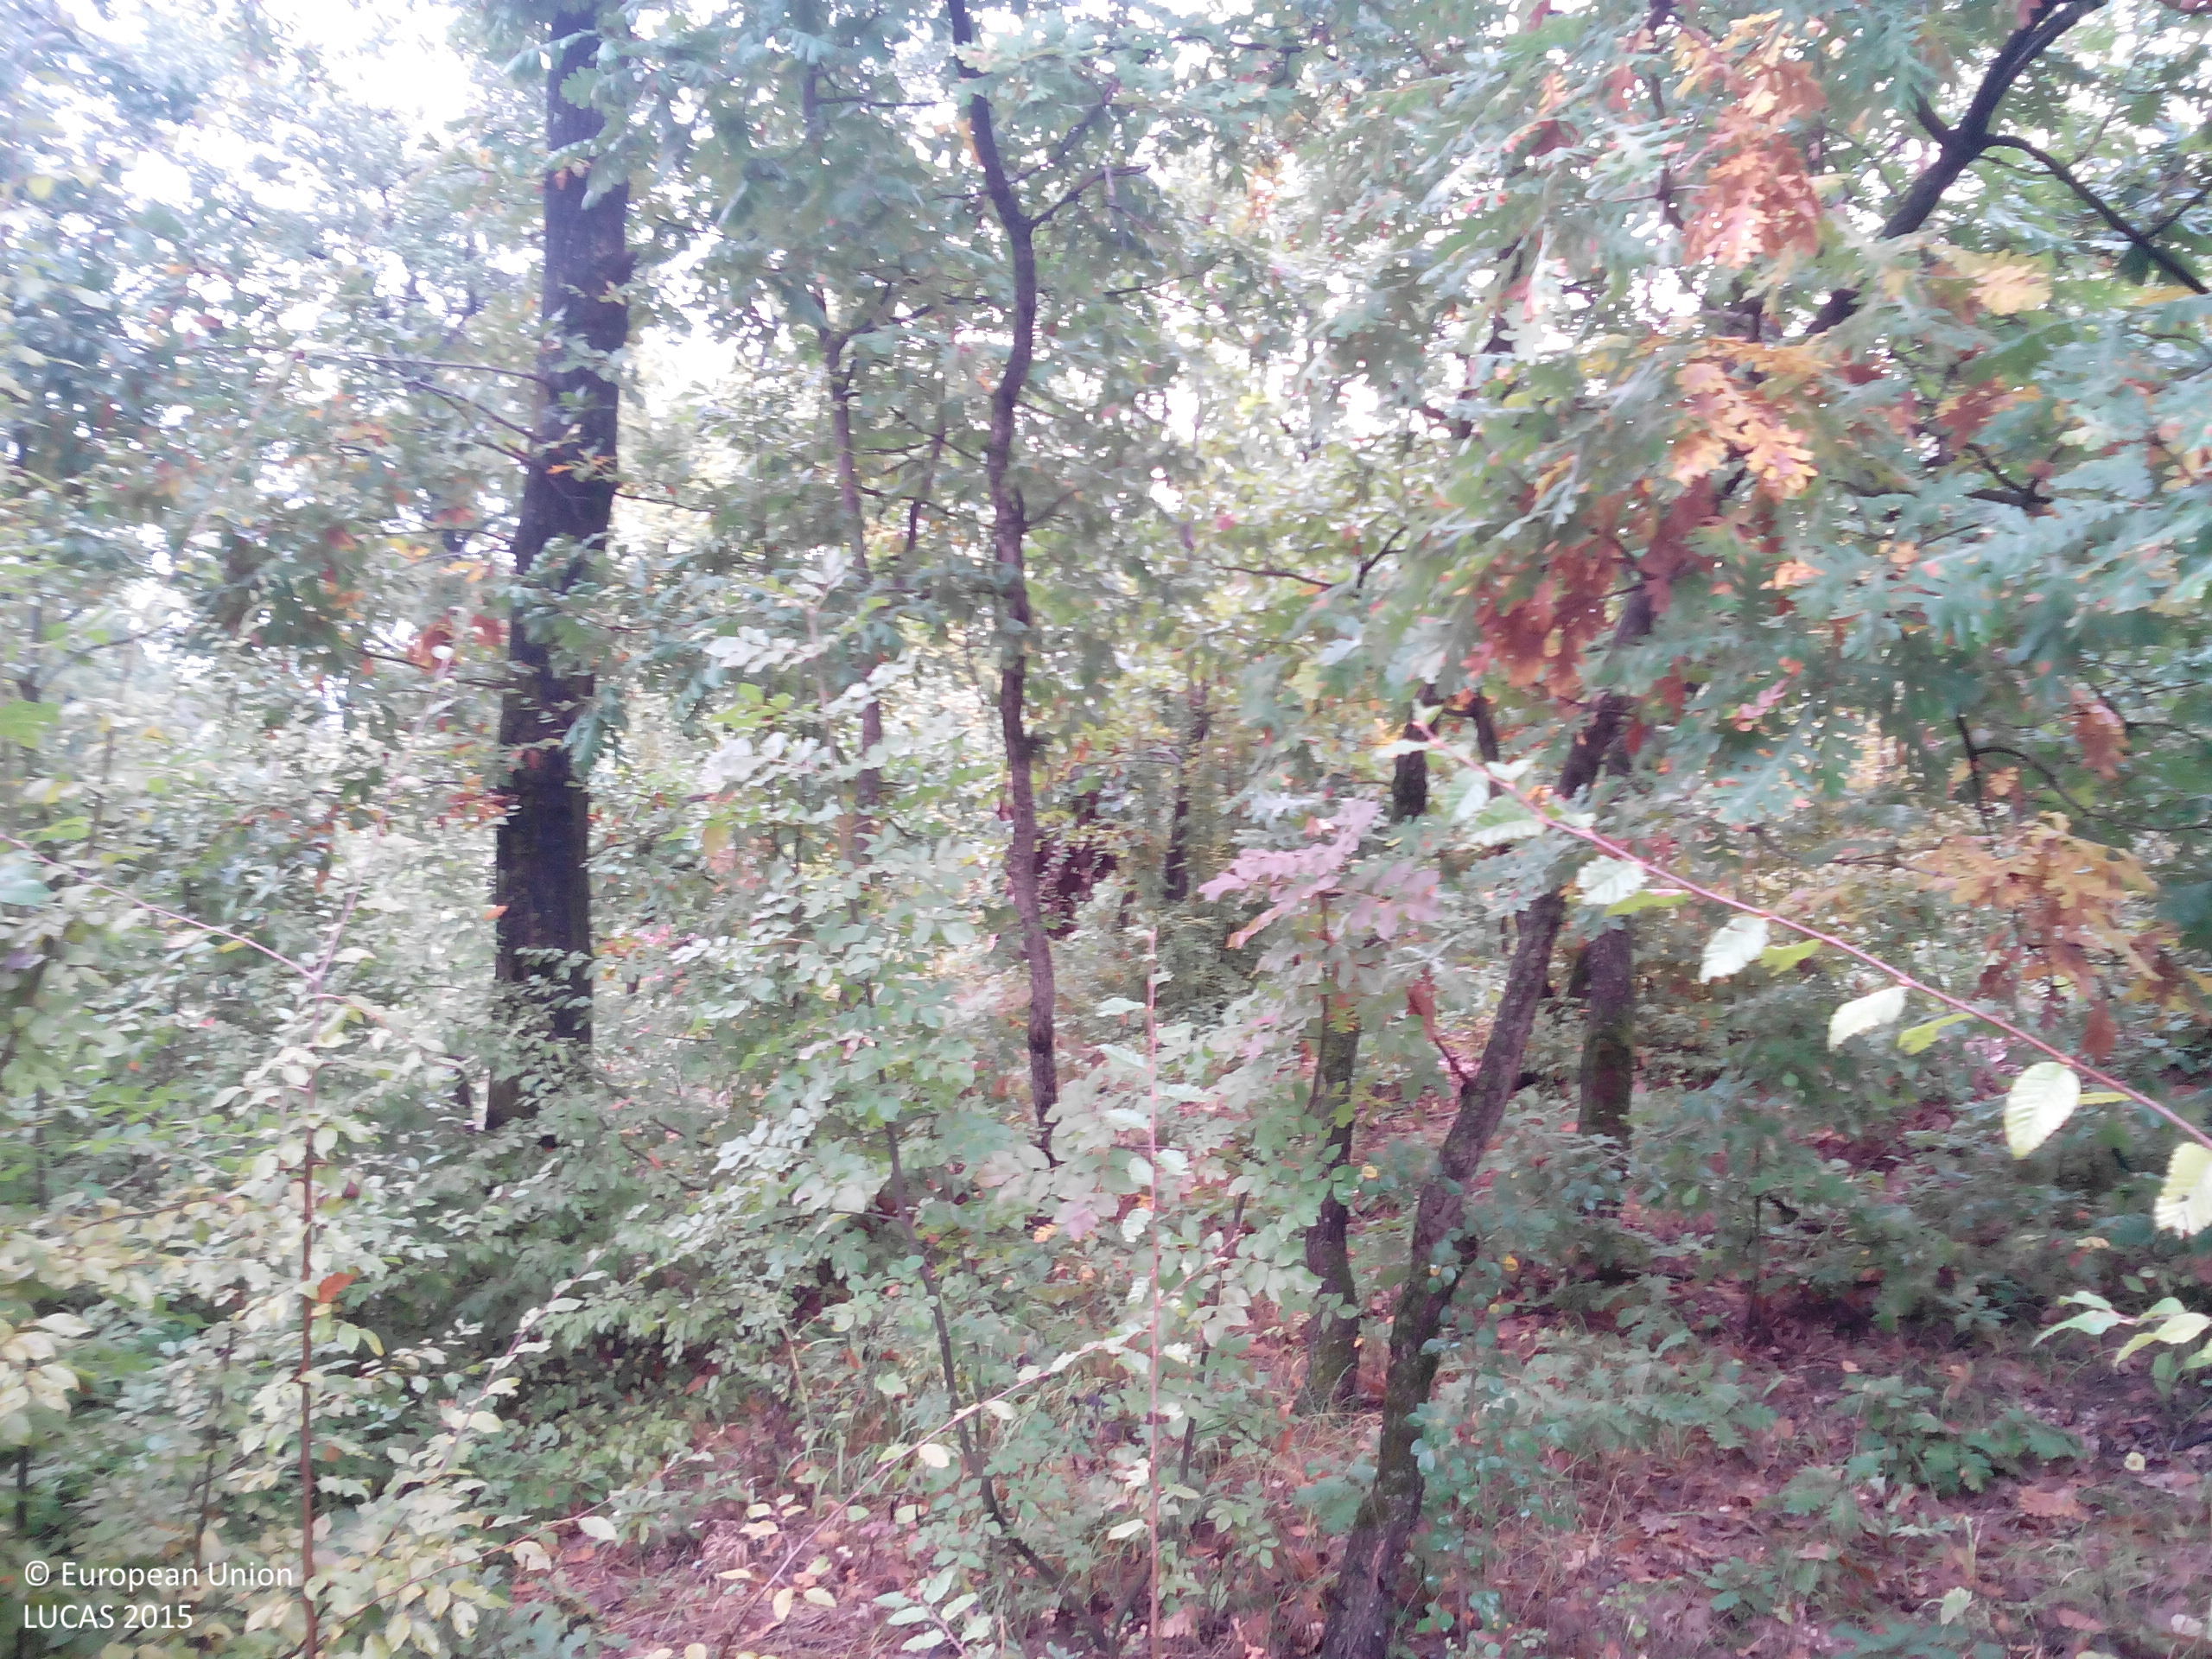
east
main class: Woodland
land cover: Broadleaved woodland
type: acidophilous oak and oak-birch forest
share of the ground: > 75 %
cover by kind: broadleaved forest trees 90 %, shrubs 5 %, herbaceous plants 5 %
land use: Forestry
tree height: > 5 m
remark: Clear cut
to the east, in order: Broadleaved woodland; Tracks; Broadleaved woodland; Tracks; Broadleaved woodland
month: October
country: BG
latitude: 43.1151
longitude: 24.0478
